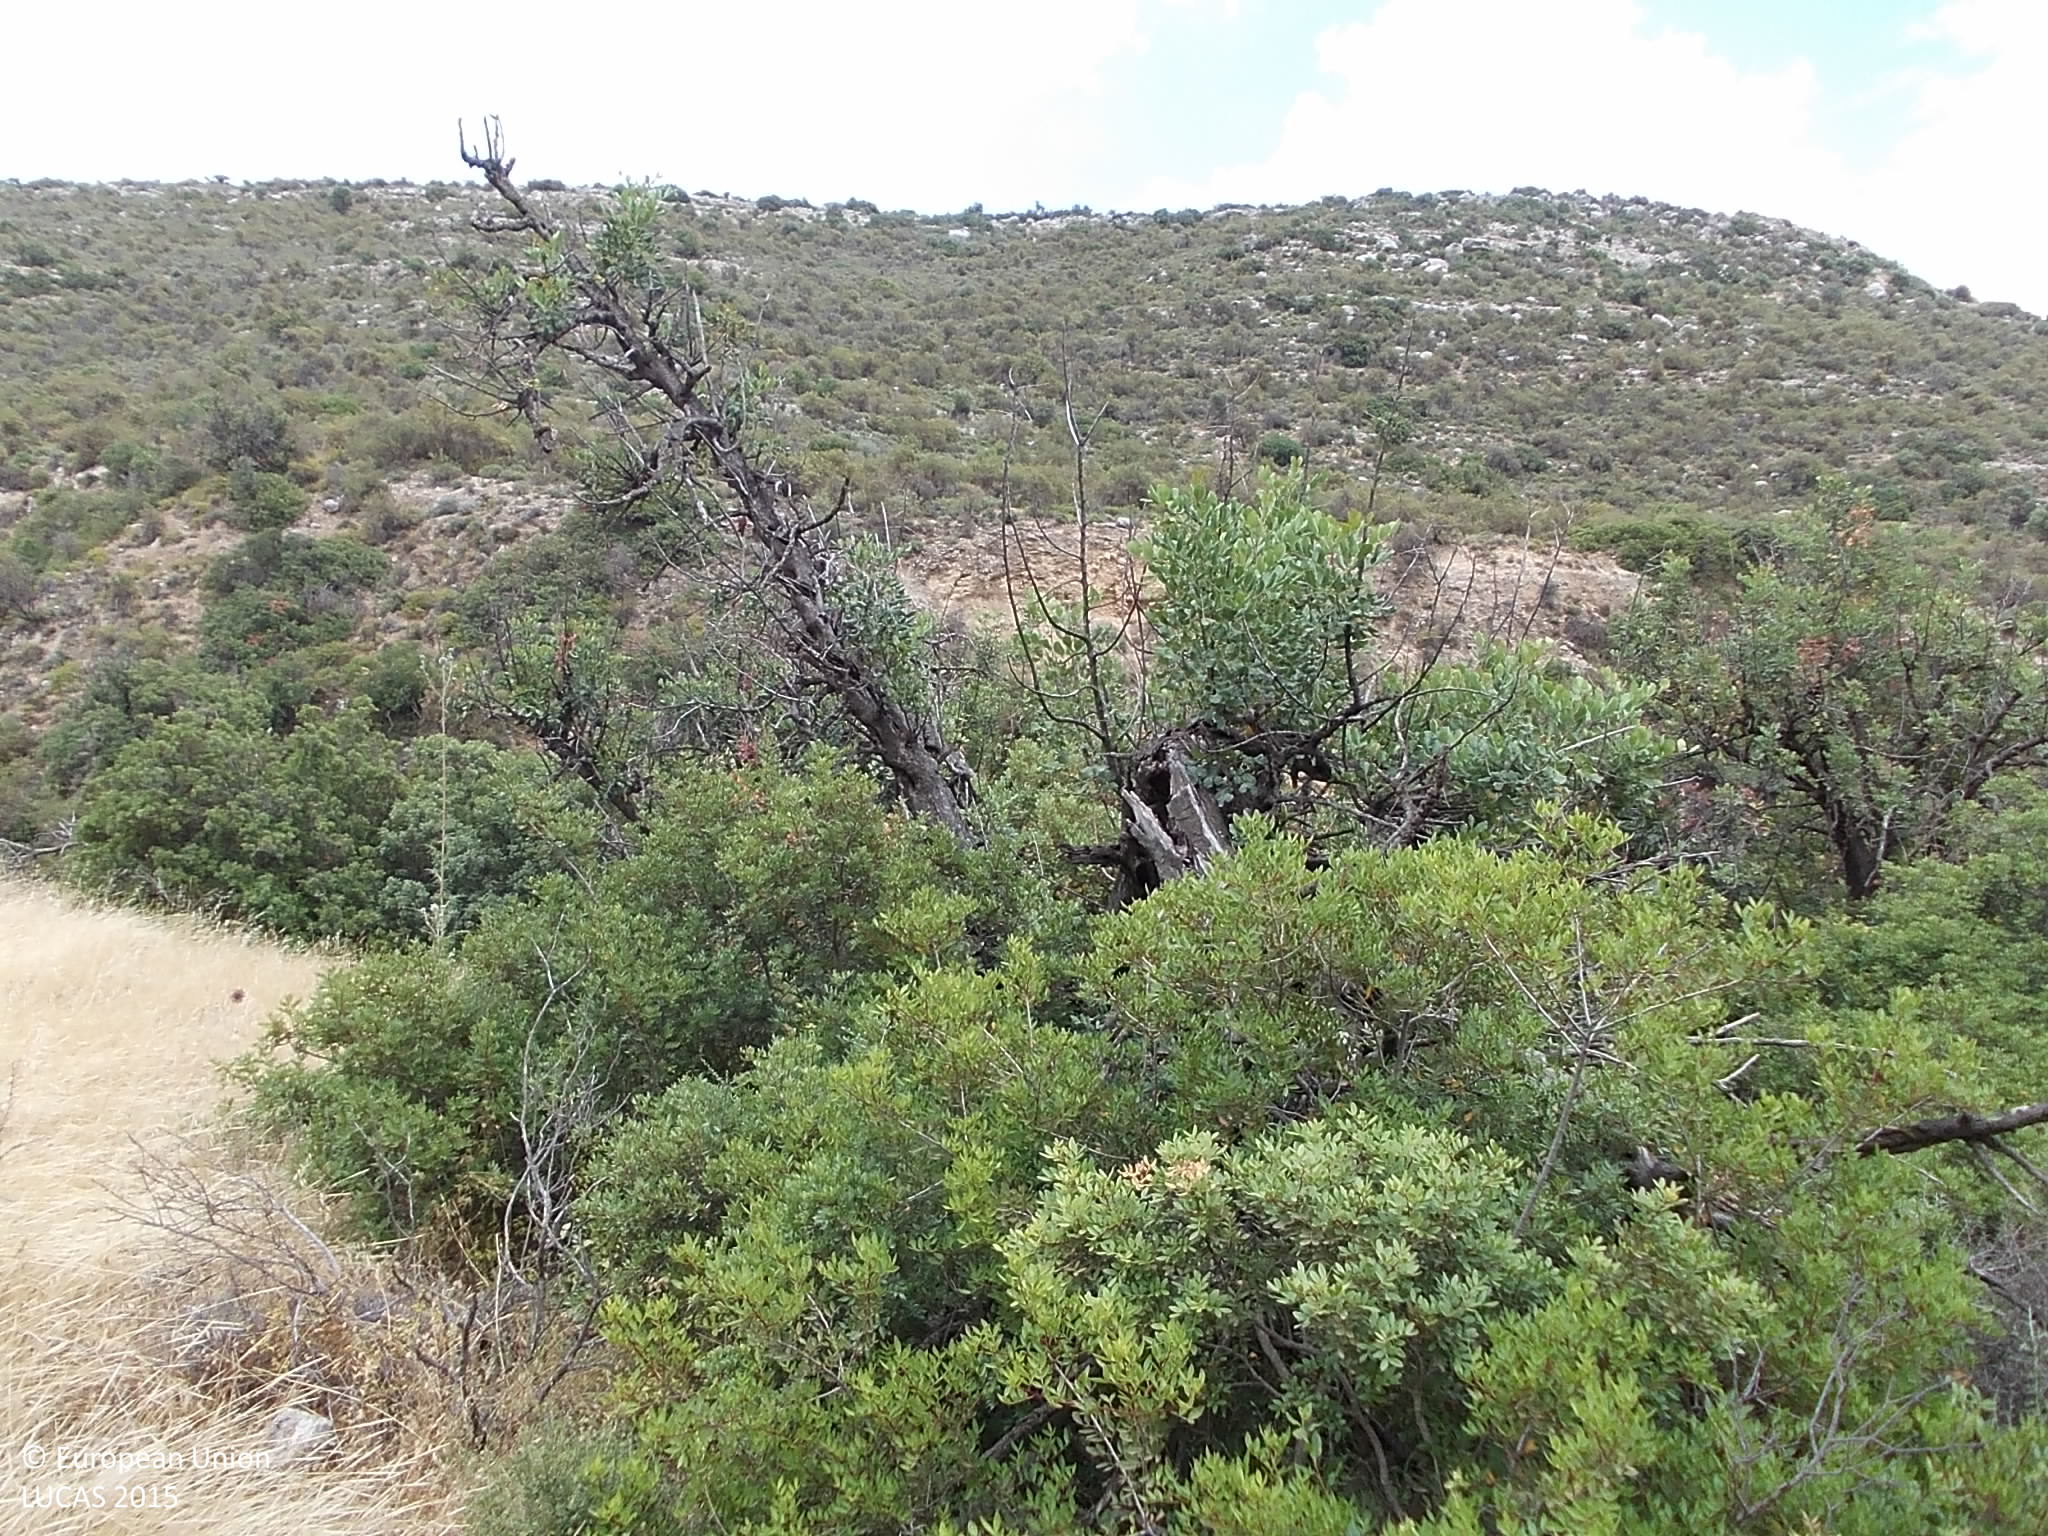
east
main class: Shrubland
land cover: Shrubland with sparse tree cover
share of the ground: > 75 %
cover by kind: shrubs 95 %, broadleaved forest trees 5 %
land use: Semi-natural and natural areas not in use
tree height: < 5 m
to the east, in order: Shrubland with sparse tree cover; Inland fresh running water; Shrubland without tree cover; Rocks and stones; Shrubland without tree cover
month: May
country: CY
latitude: 34.7158
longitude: 32.7917
